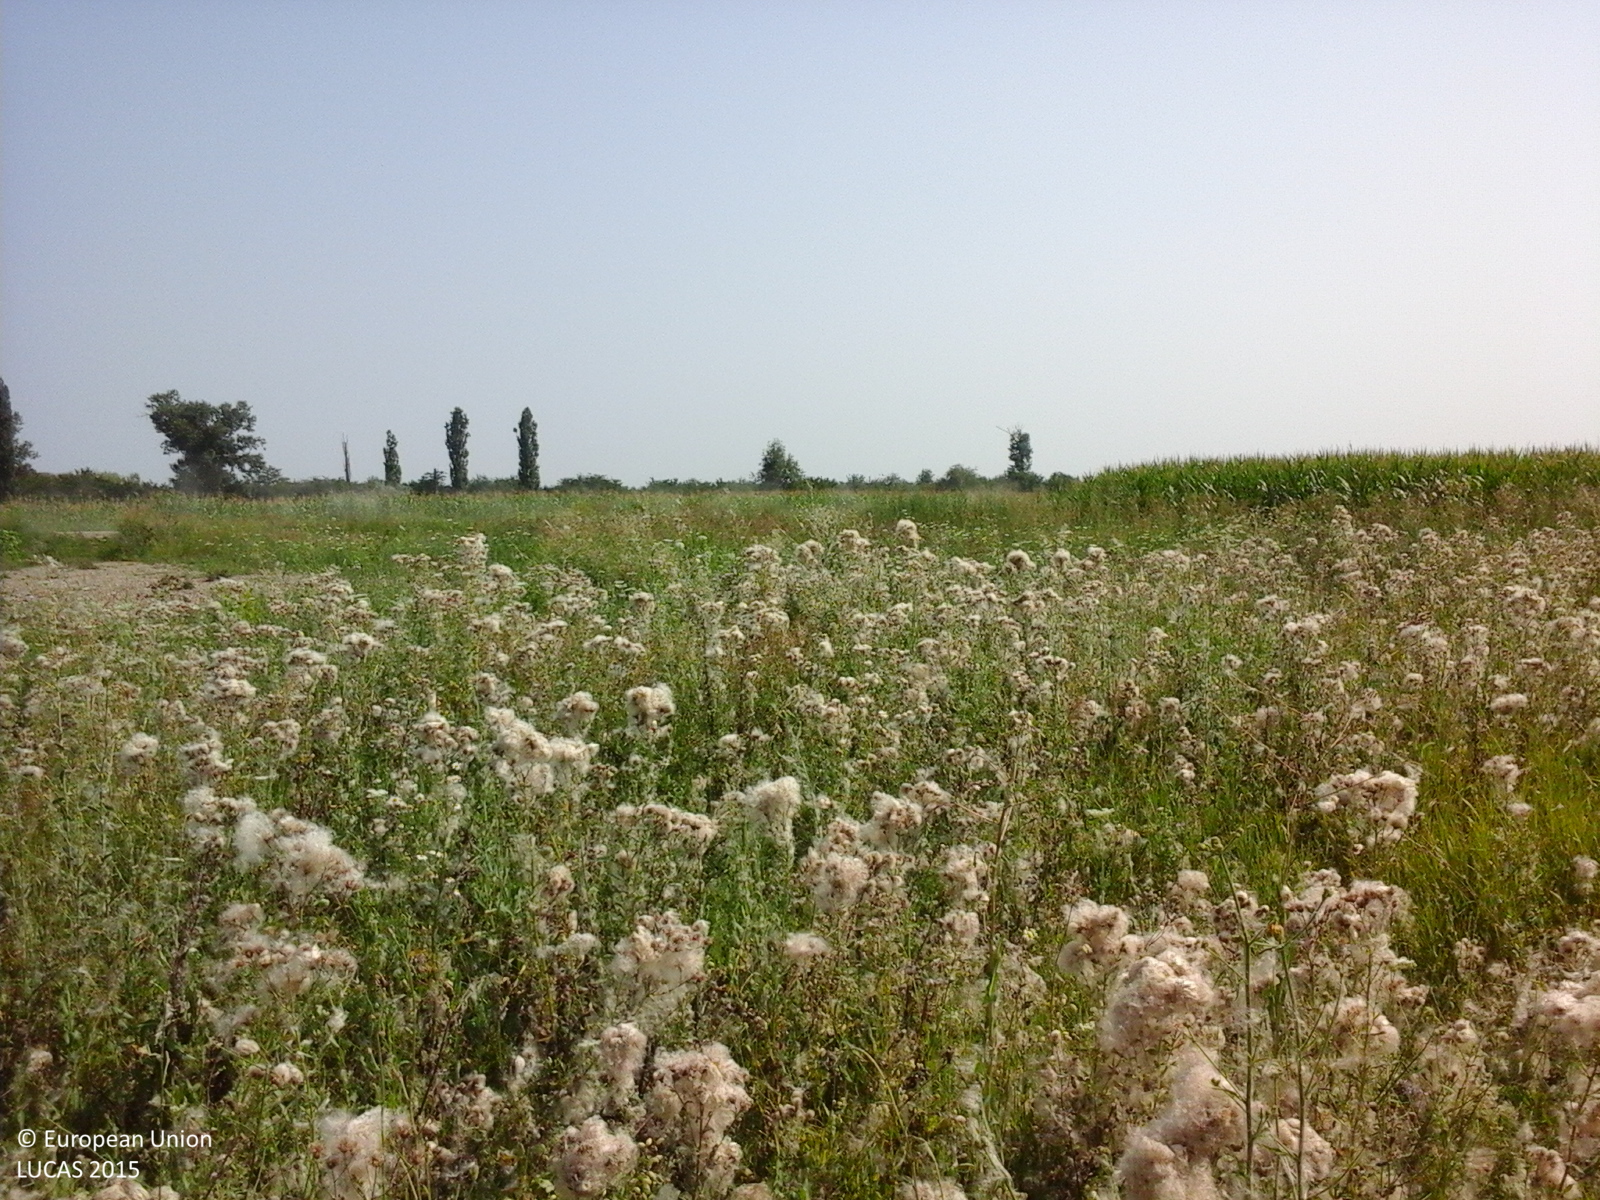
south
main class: Cropland
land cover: Maize
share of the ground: > 75 %
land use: Agriculture (excluding fallow land and kitchen gardens)
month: July
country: RO
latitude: 44.8168
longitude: 26.8586
